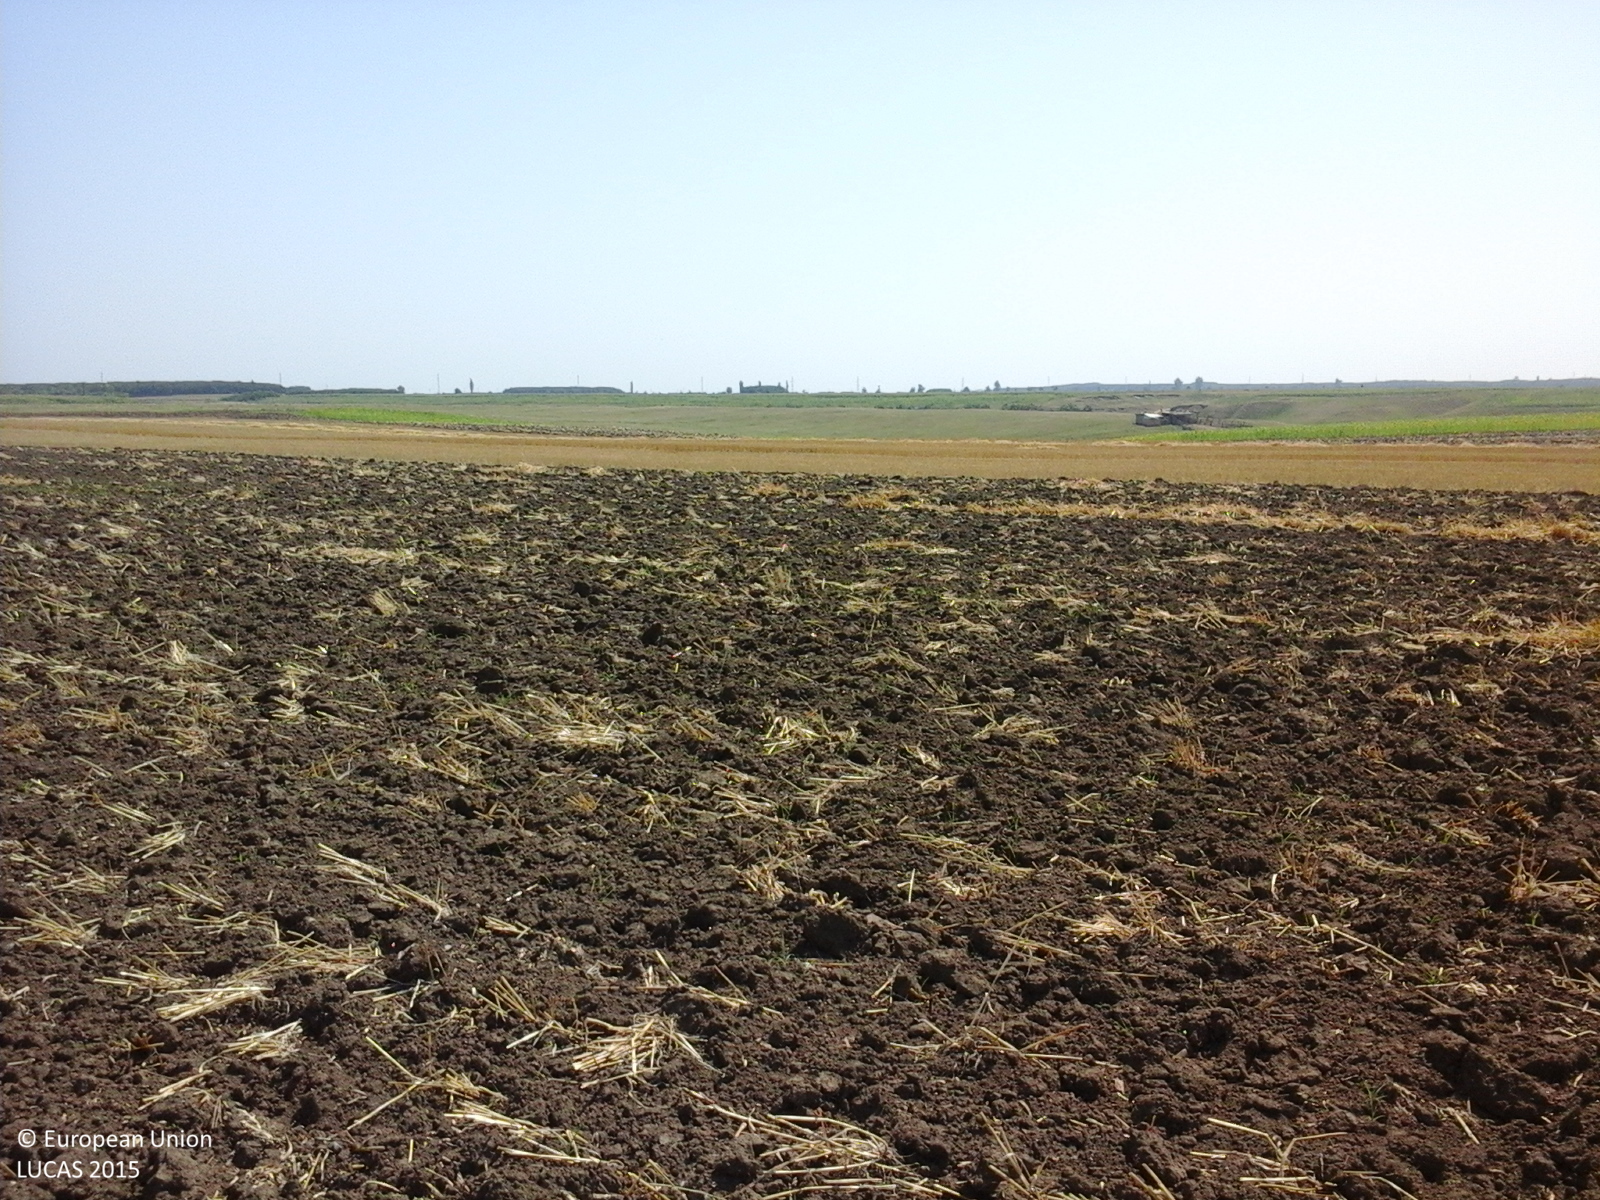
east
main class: Cropland
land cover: Barley
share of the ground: < 10 %
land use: Agriculture (excluding fallow land and kitchen gardens)
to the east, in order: Barley; Sunflower; Grassland without tree/shrub cover
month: July
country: RO
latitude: 44.4585
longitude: 26.8009
